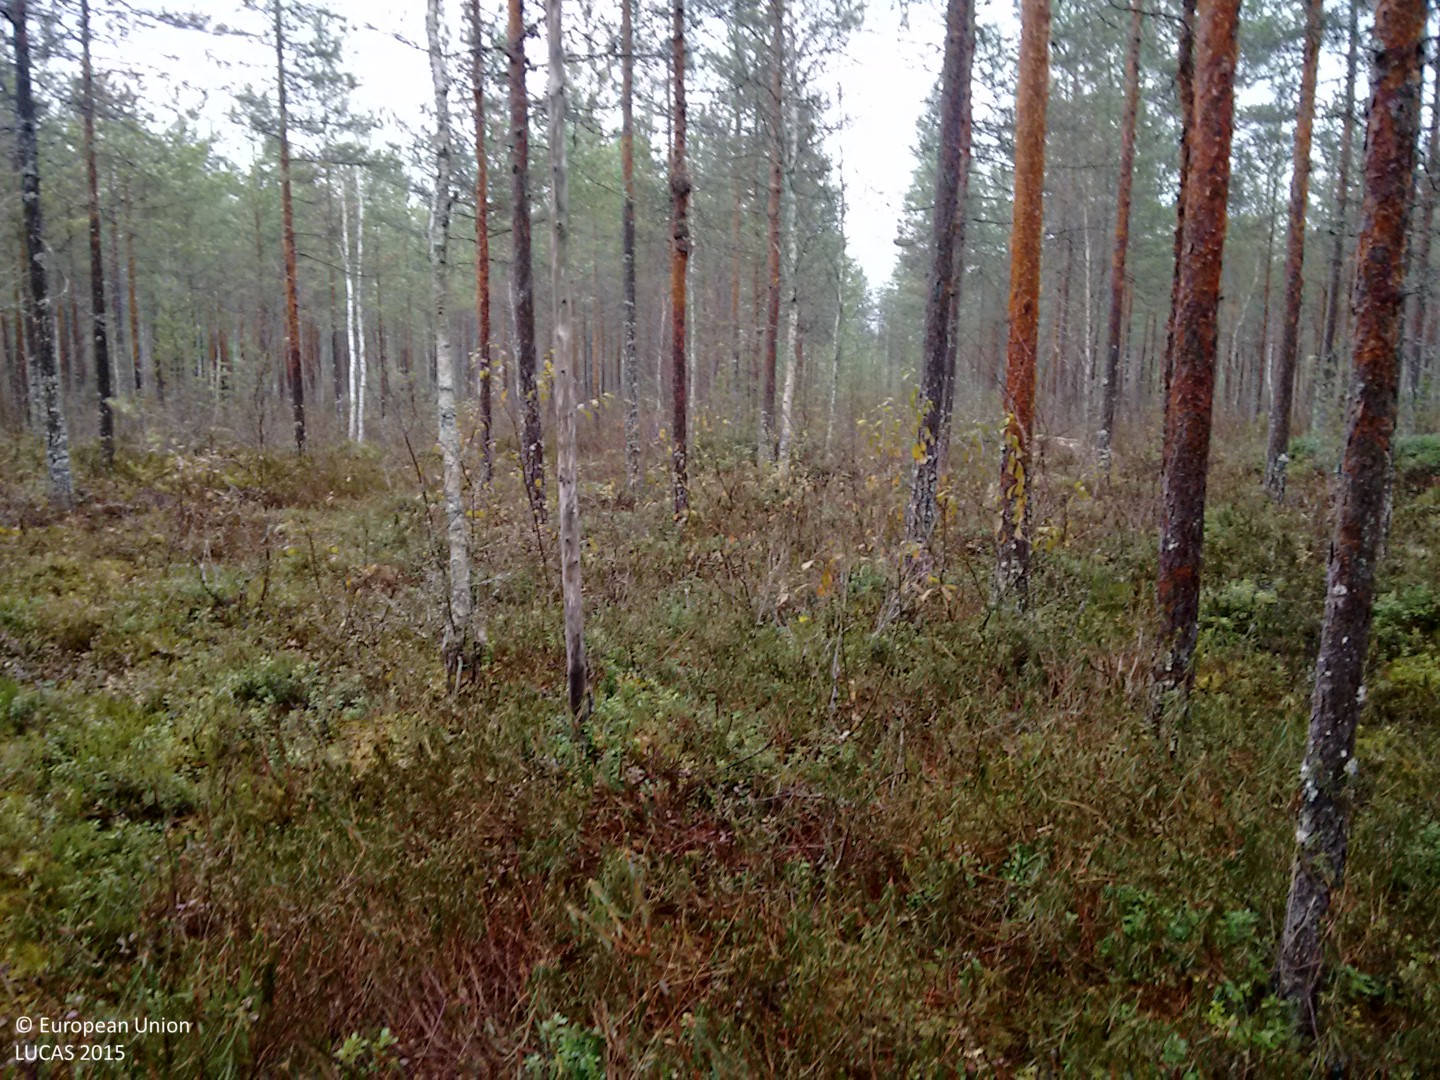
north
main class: Woodland
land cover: Pine dominated coniferous woodland
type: boreal forest
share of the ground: 50 - 75 %
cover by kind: coniferous forest trees 70 %, shrubs 25 %, lichens and mosses 5 %
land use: Forestry
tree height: > 5 m
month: October
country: FI
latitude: 64.6550
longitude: 24.8346
